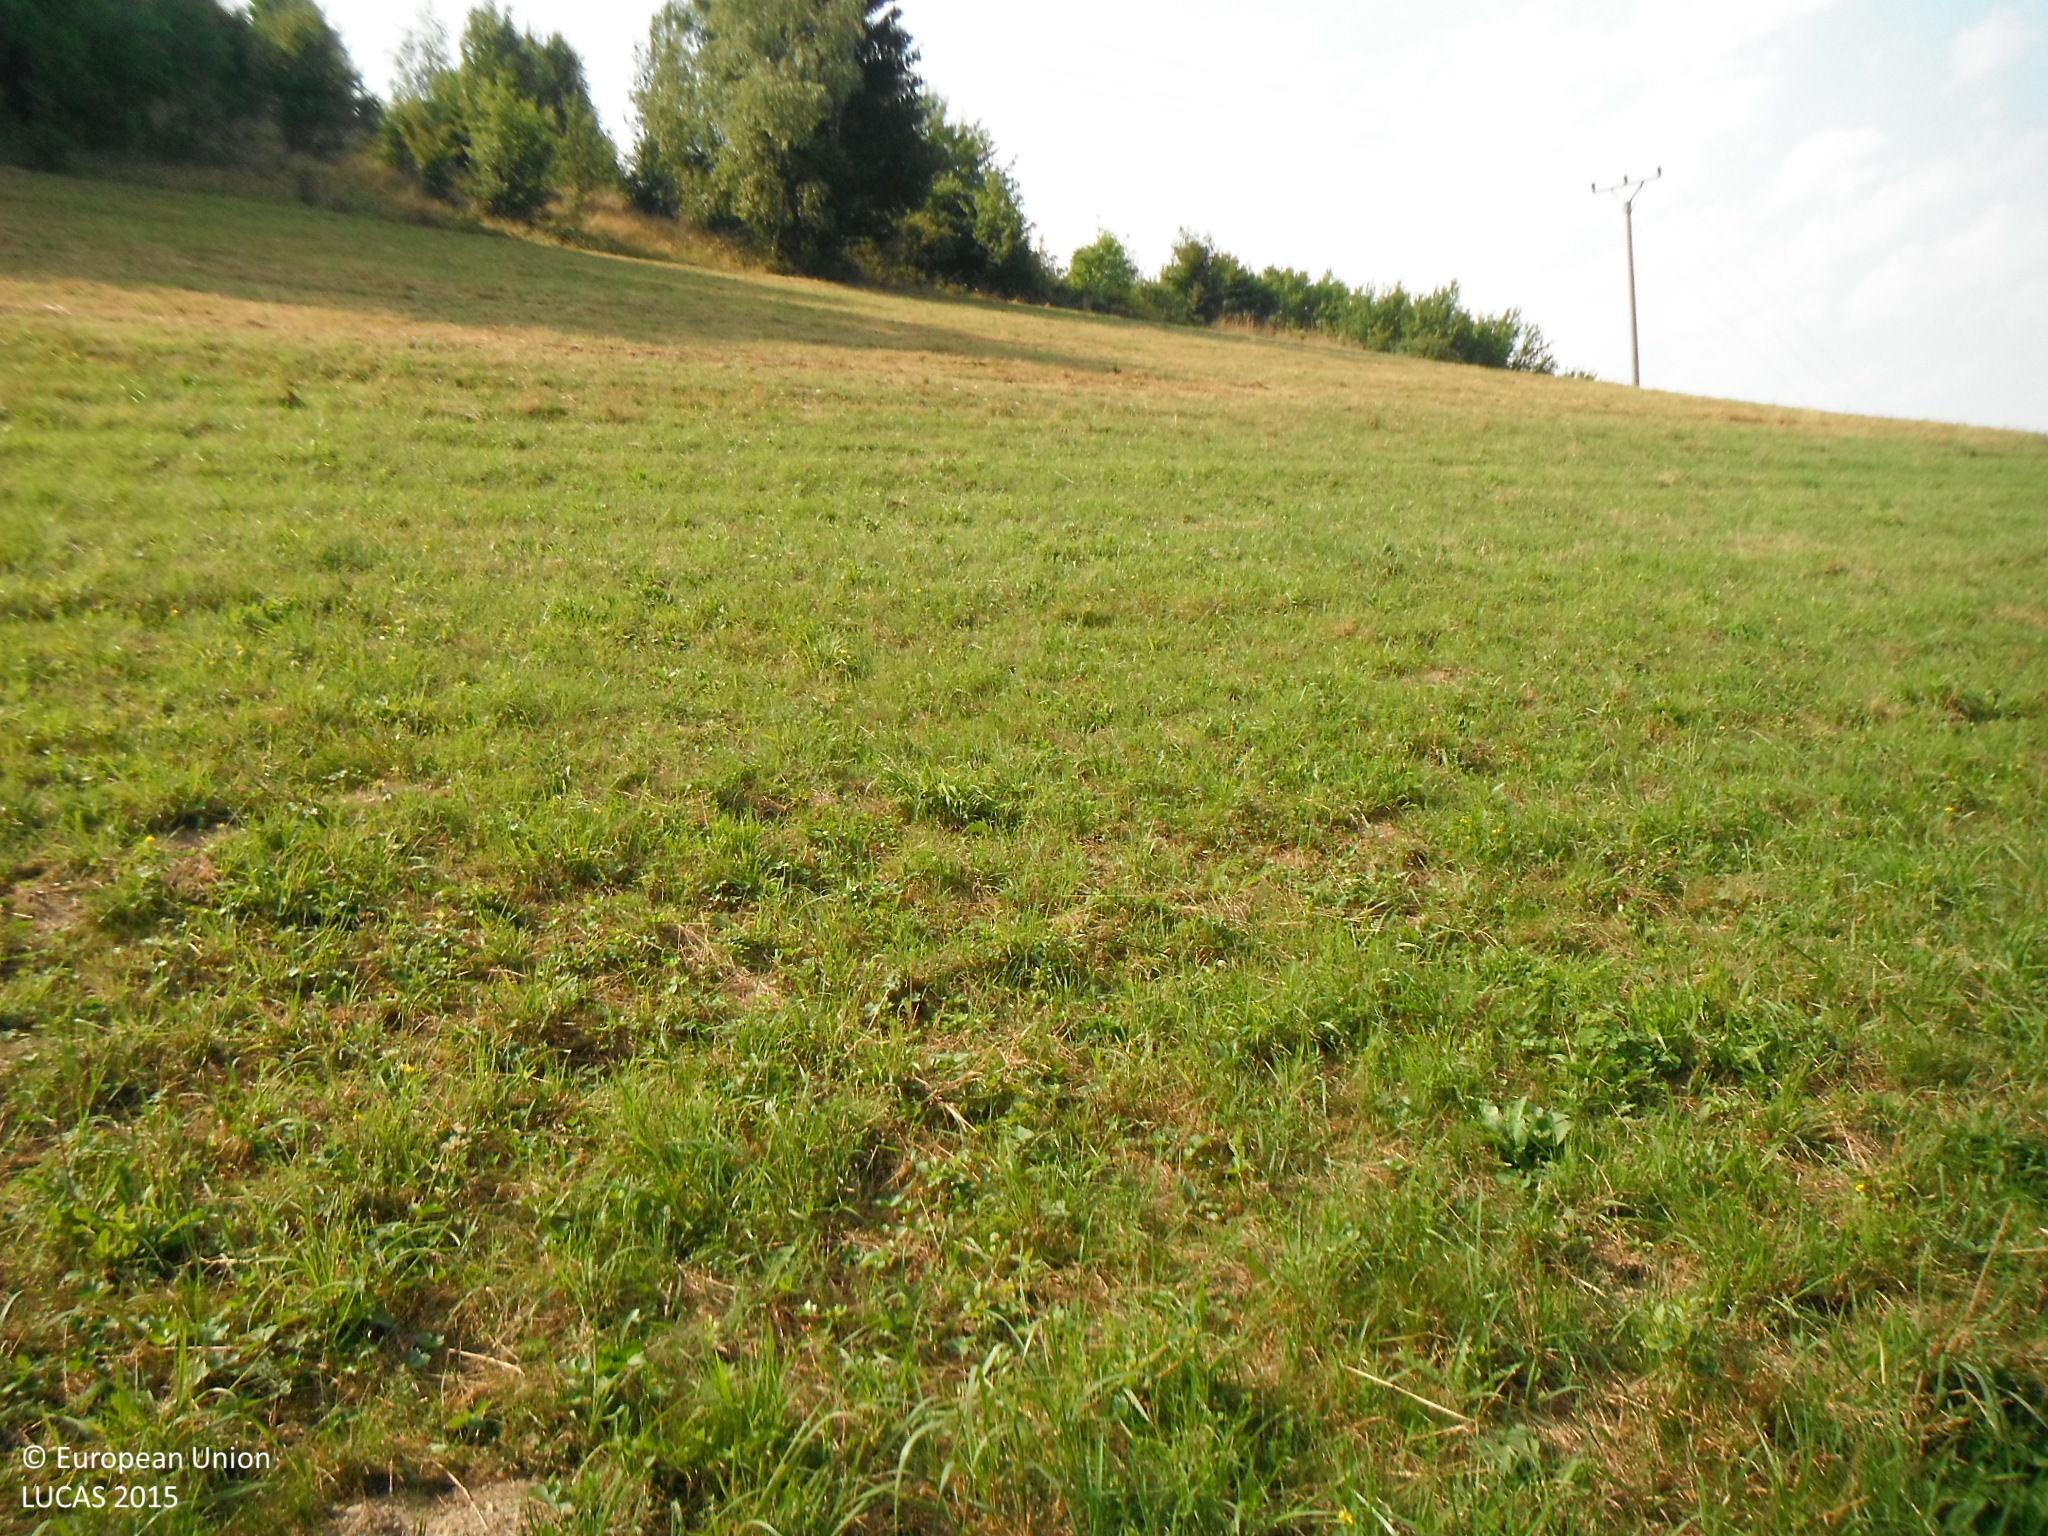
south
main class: Grassland
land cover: Grassland without tree/shrub cover
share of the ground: > 75 %
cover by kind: herbaceous plants 100 %
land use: Agriculture (excluding fallow land and kitchen gardens)
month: August
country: SK
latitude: 49.1332
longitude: 18.3913
